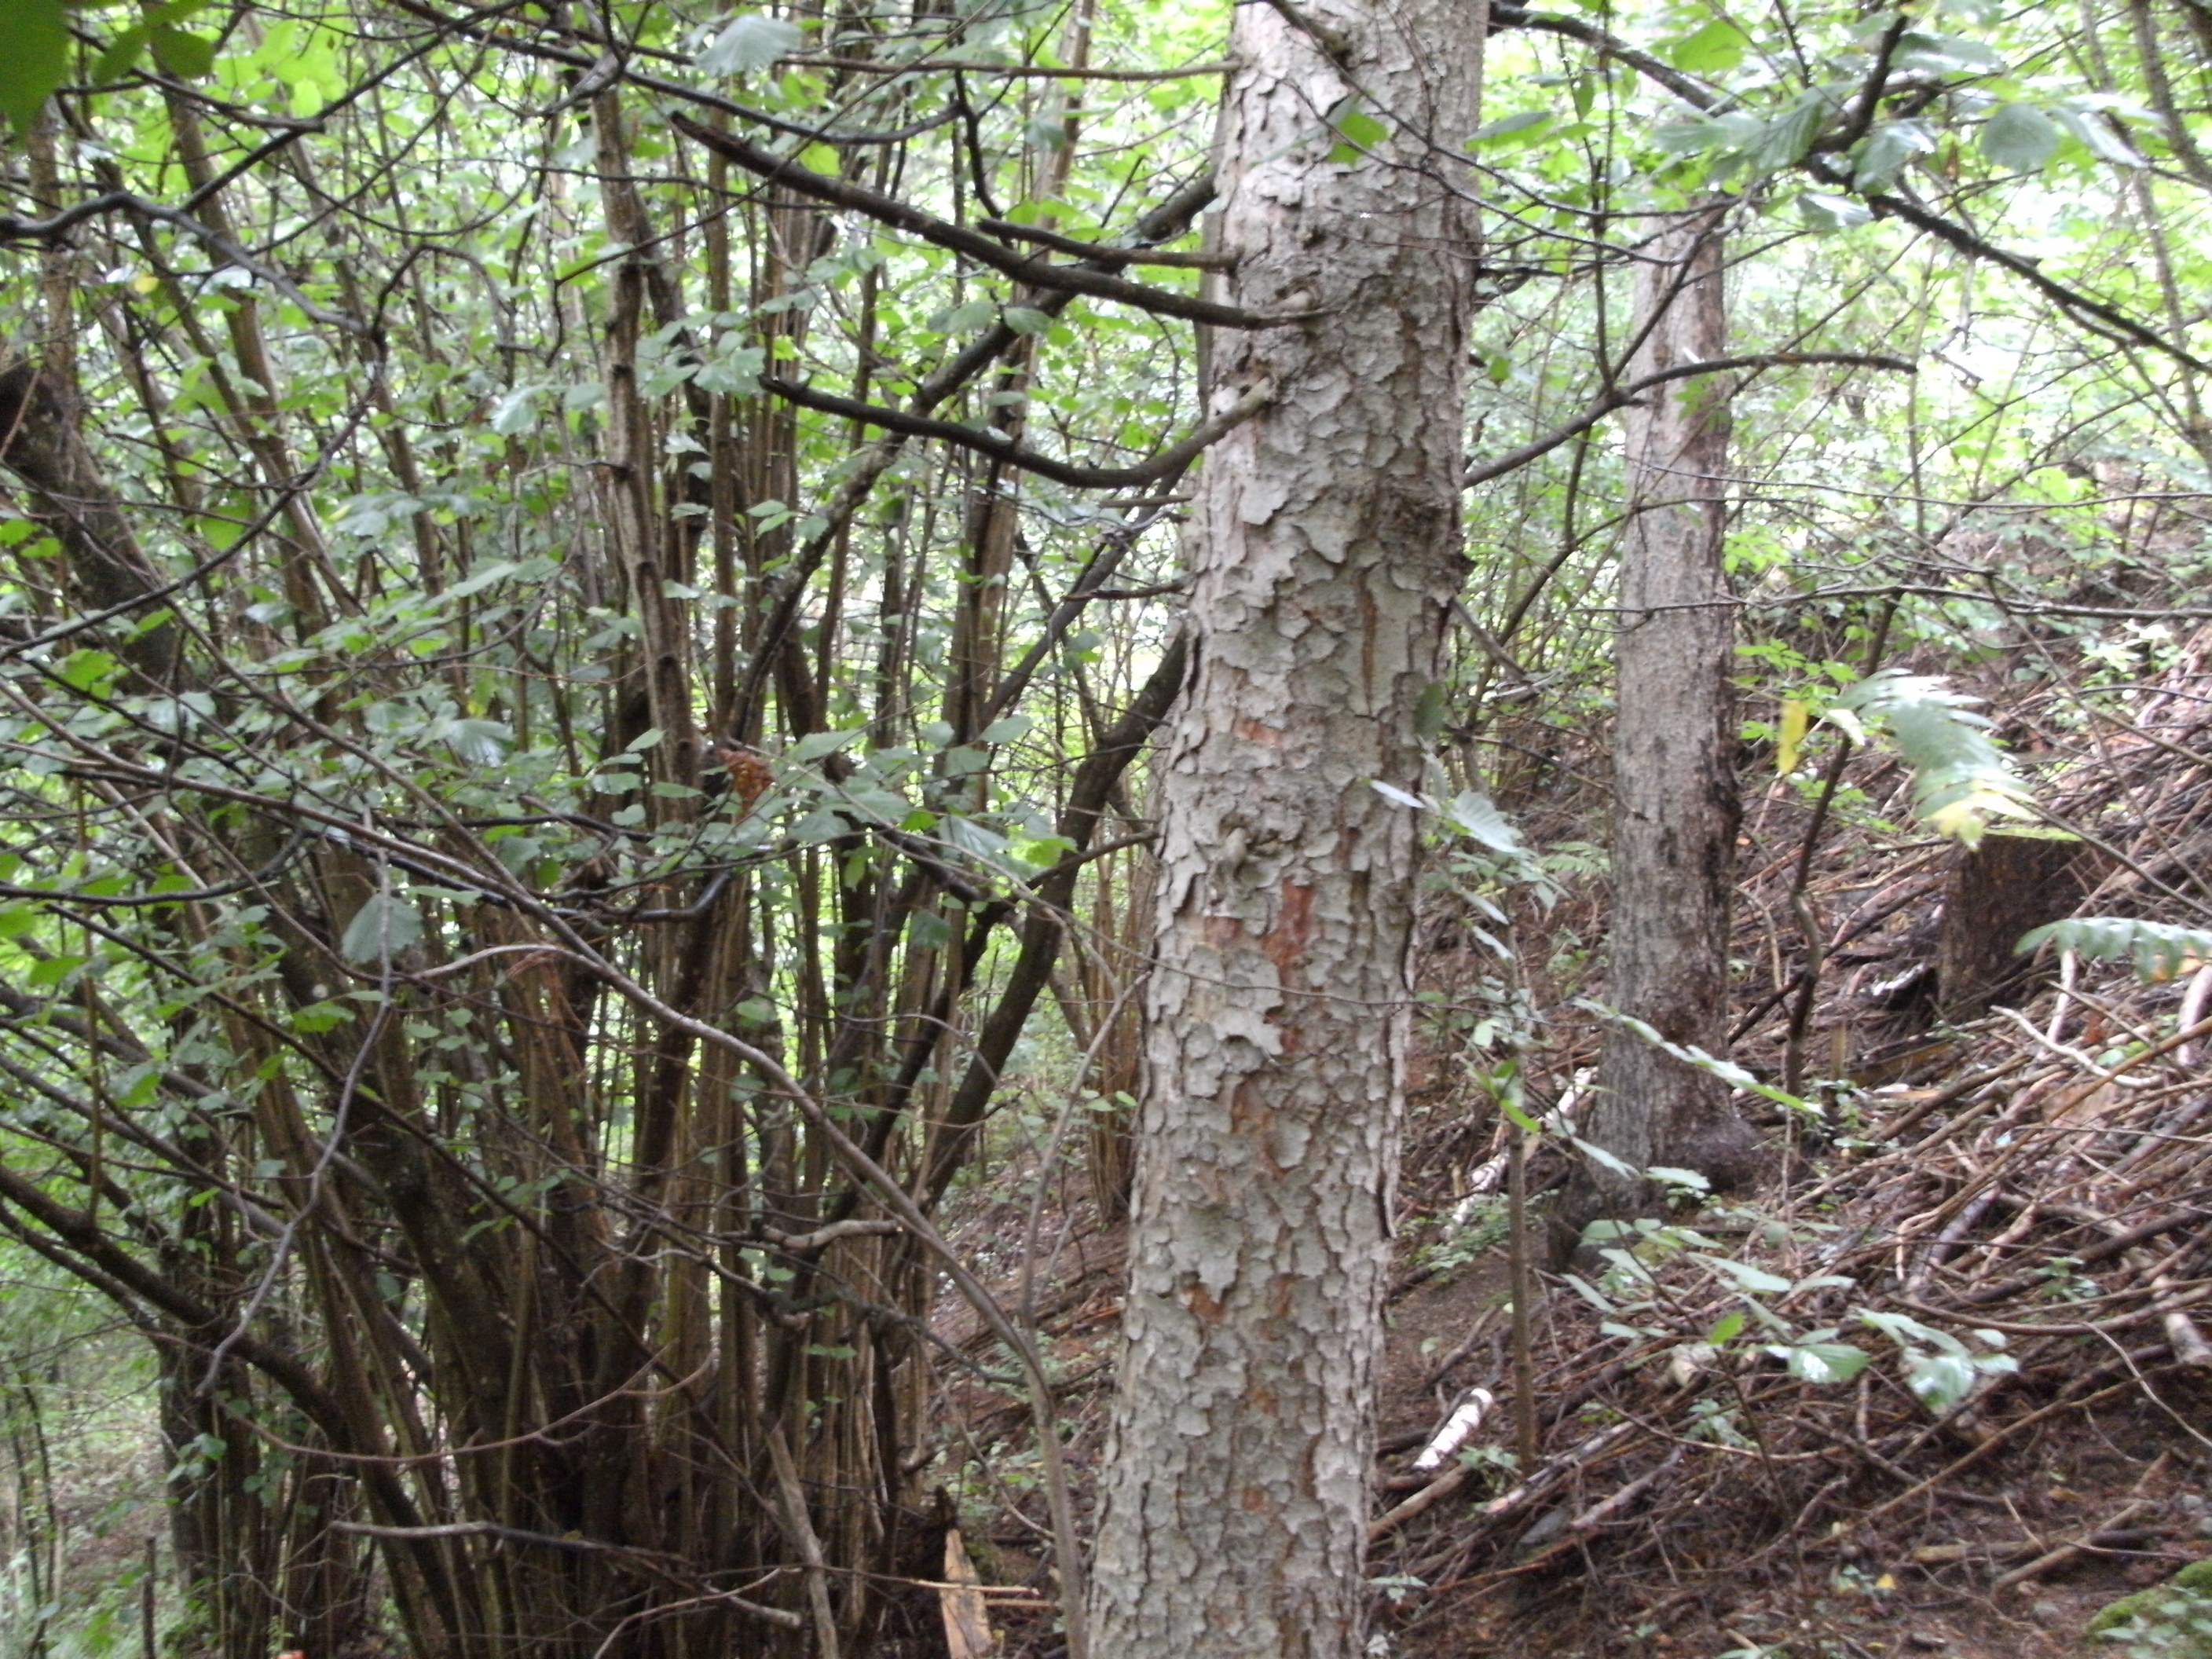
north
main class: Woodland
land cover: Spruce dominated mixed woodland
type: hemiboreal forest and nemoral coniferous forest and mixed broadleaved-coniferous forest
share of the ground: > 75 %
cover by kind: coniferous forest trees 50 %, broadleaved forest trees 30 %, shrubs 20 %
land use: Forestry
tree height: > 5 m
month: July
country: AT
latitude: 46.9449
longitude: 14.8464
